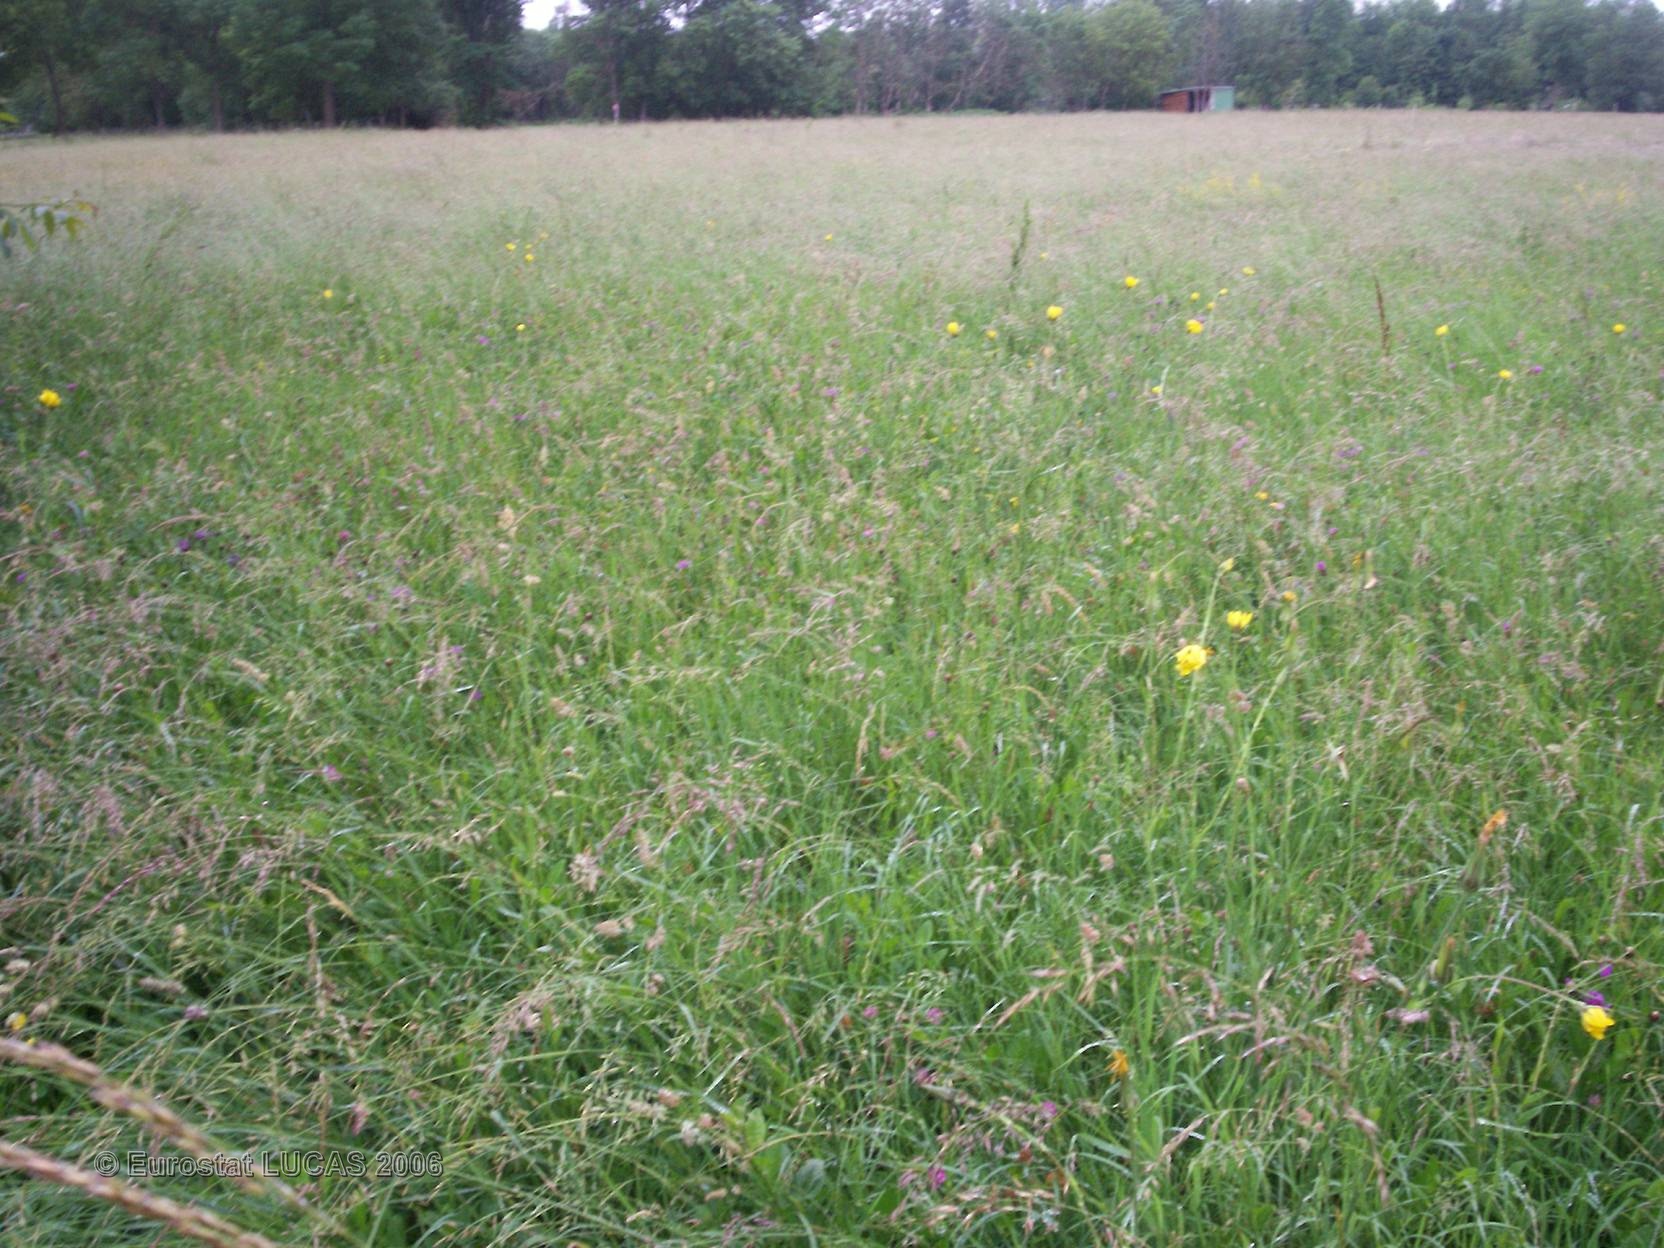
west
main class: Cropland
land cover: Other fresh vegetables
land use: Kitchen garden
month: May
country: FR
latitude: 46.7202
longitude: 0.4436
